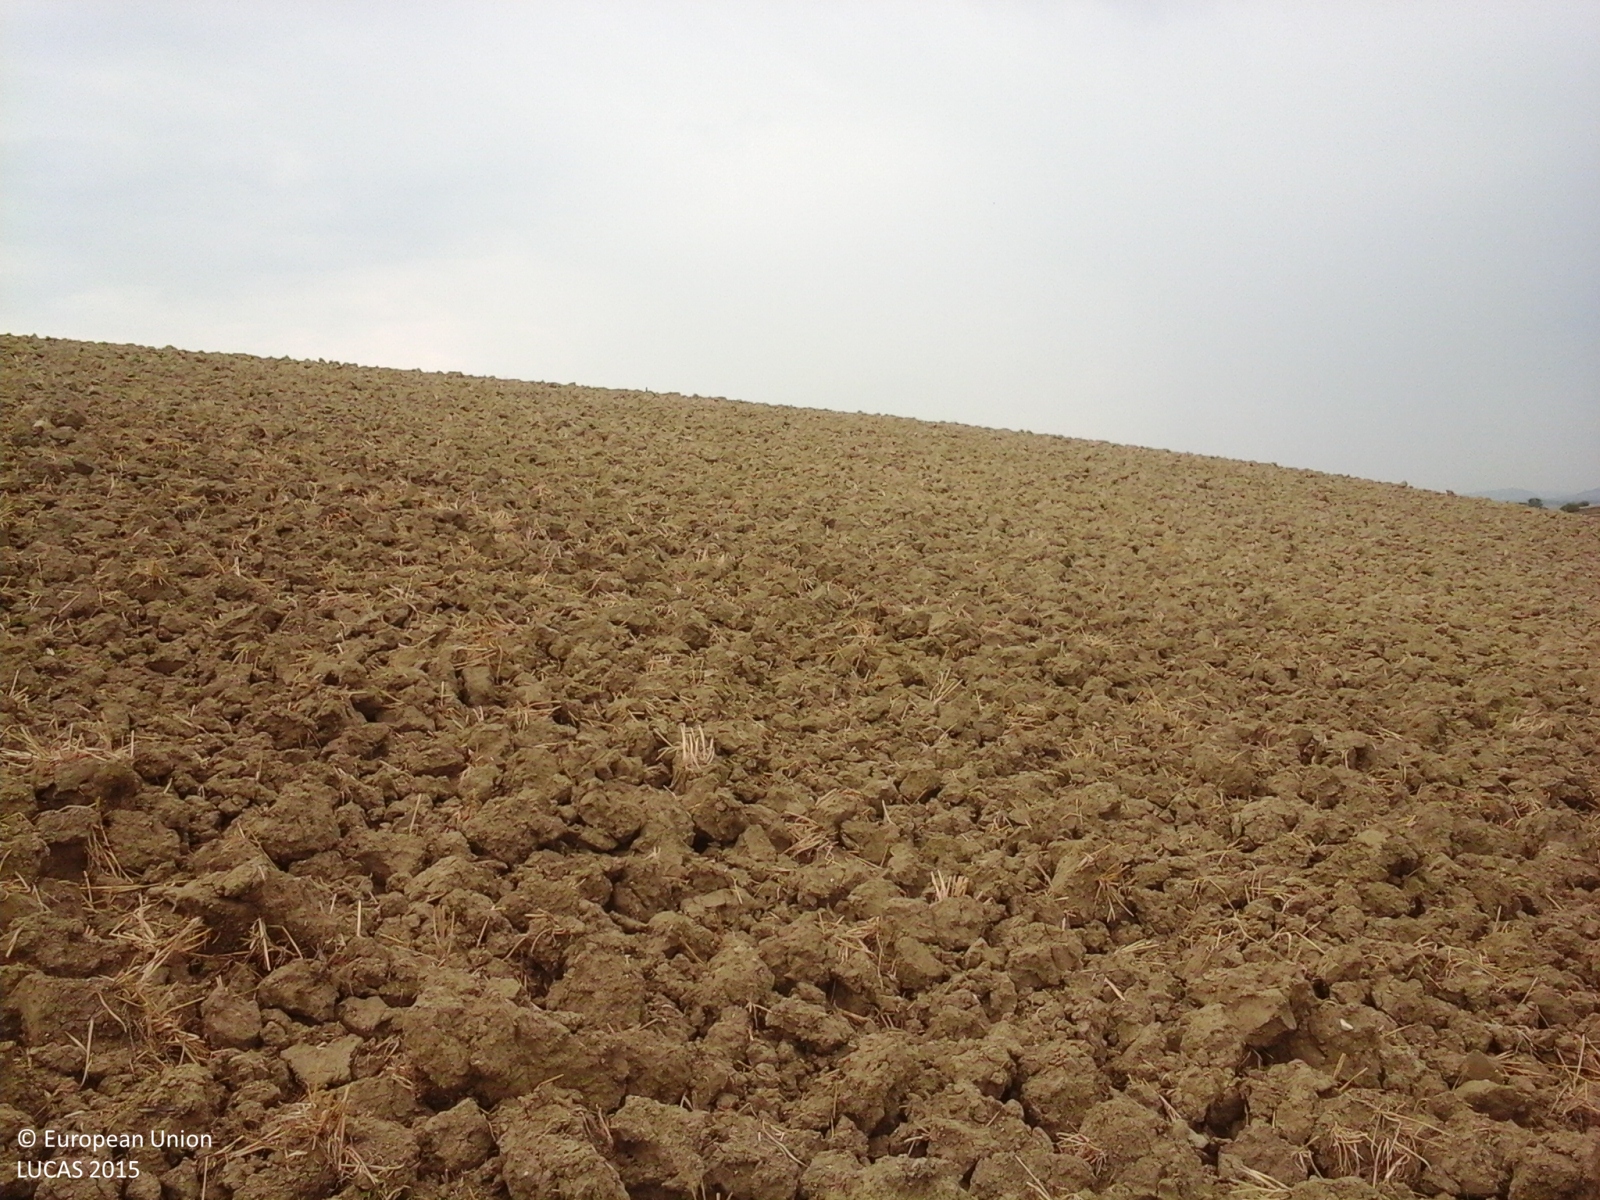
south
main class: Cropland
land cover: Durum wheat
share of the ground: > 75 %
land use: Agriculture (excluding fallow land and kitchen gardens)
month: August
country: IT
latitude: 43.4121
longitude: 13.3383
